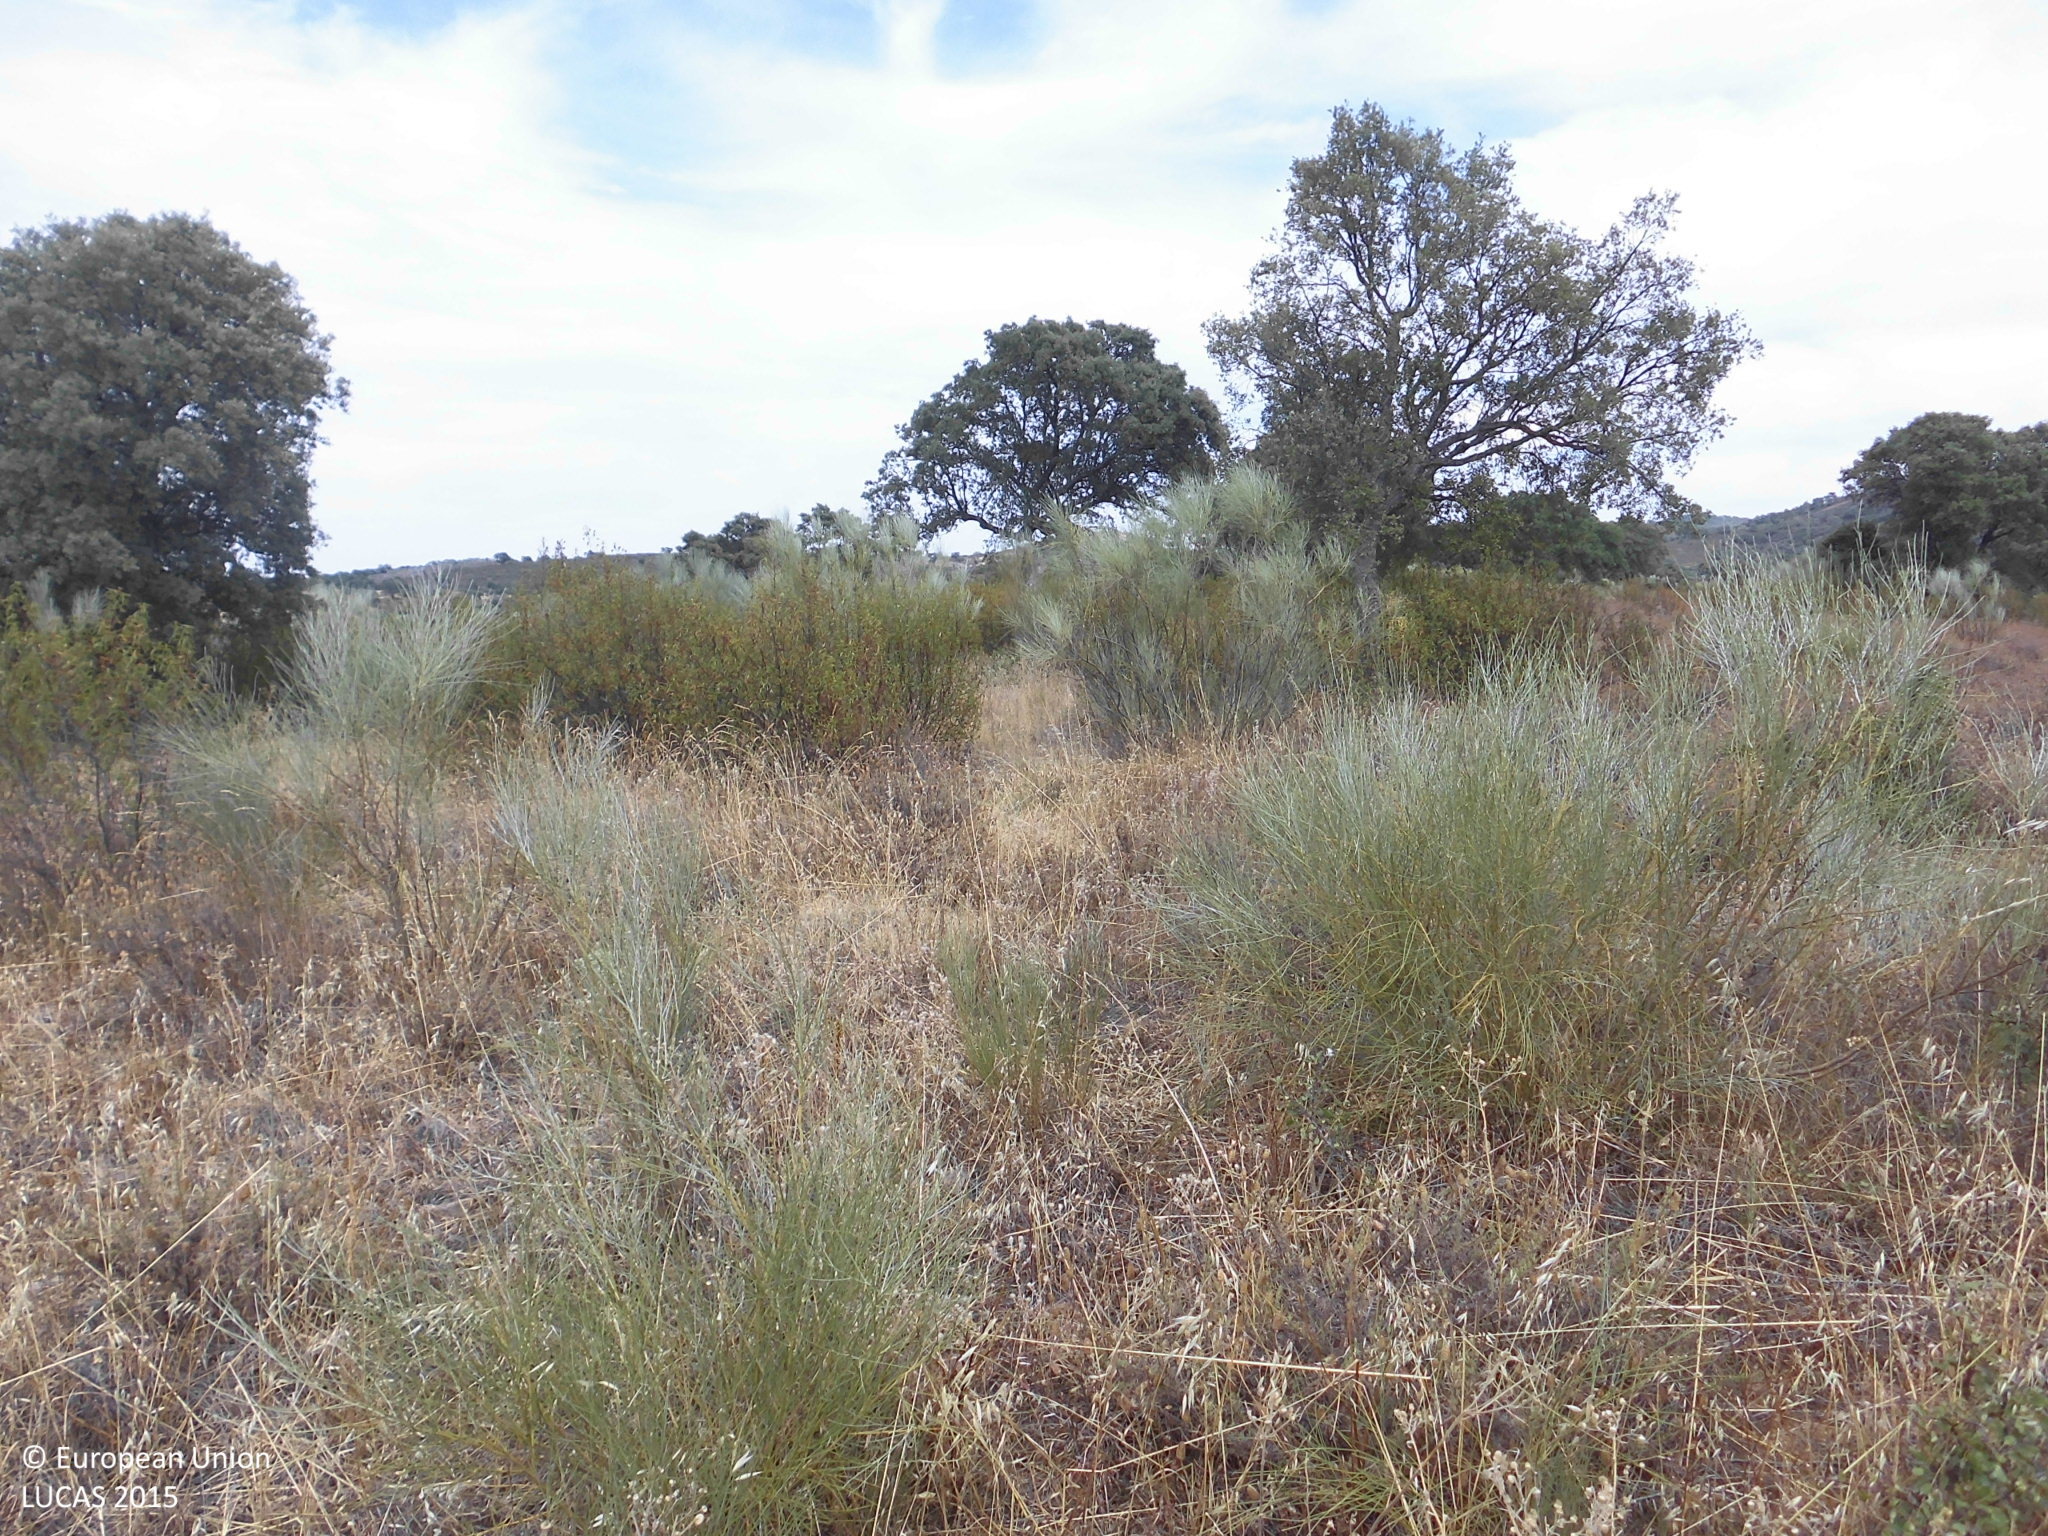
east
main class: Shrubland
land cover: Shrubland with sparse tree cover
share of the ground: 10 - 25 %
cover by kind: herbaceous plants 75 %, shrubs 20 %, broadleaved forest trees 5 %
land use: Agriculture (excluding fallow land and kitchen gardens)
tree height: > 5 m
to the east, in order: Shrubland with sparse tree cover; Grassland with sparse tree/shrub cover; Grass margins; Tracks; Grass margins; Shrubland with sparse tree cover
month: July
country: ES
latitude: 39.8229
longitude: -6.4673
